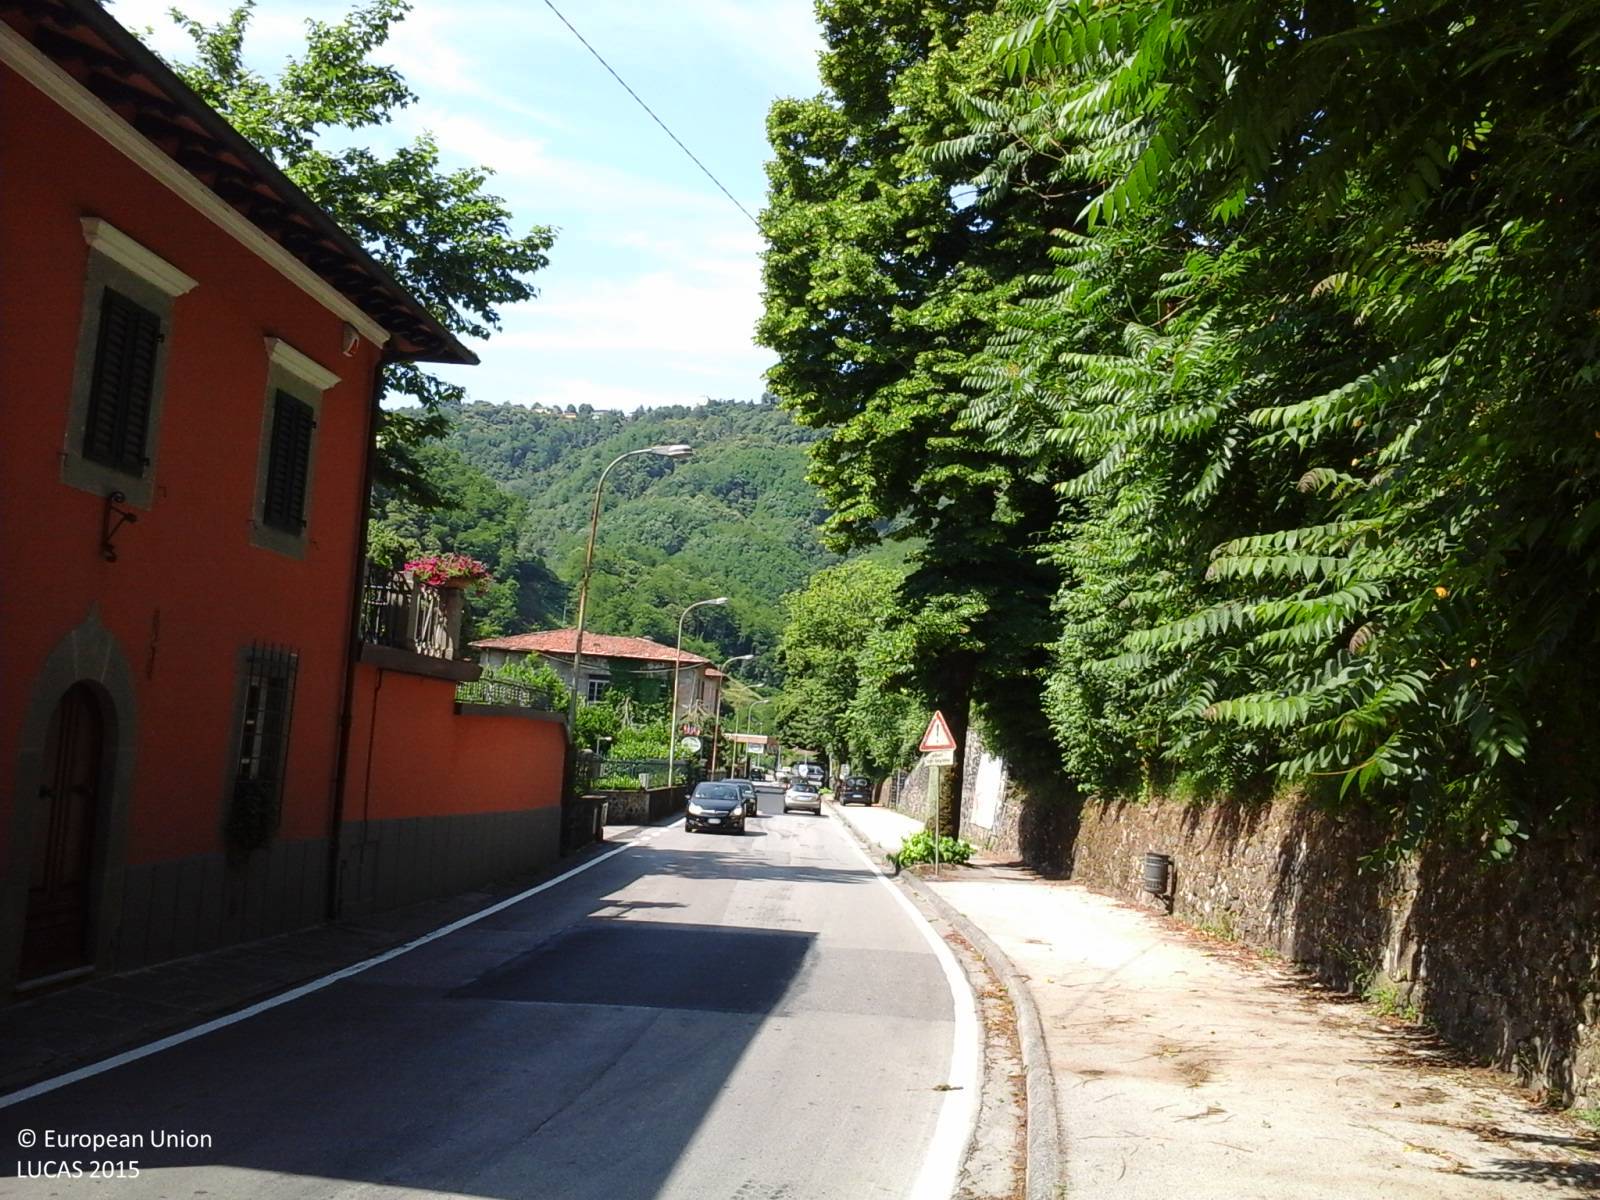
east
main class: Woodland
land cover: Broadleaved woodland
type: thermophilous deciduous forest
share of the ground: > 75 %
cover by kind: broadleaved forest trees 100 %
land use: Semi-natural and natural areas not in use
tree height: > 5 m
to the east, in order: Broadleaved woodland; Artificial constructions in urban areas; Inland fresh running water
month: June
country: IT
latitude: 44.0062
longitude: 10.5847
